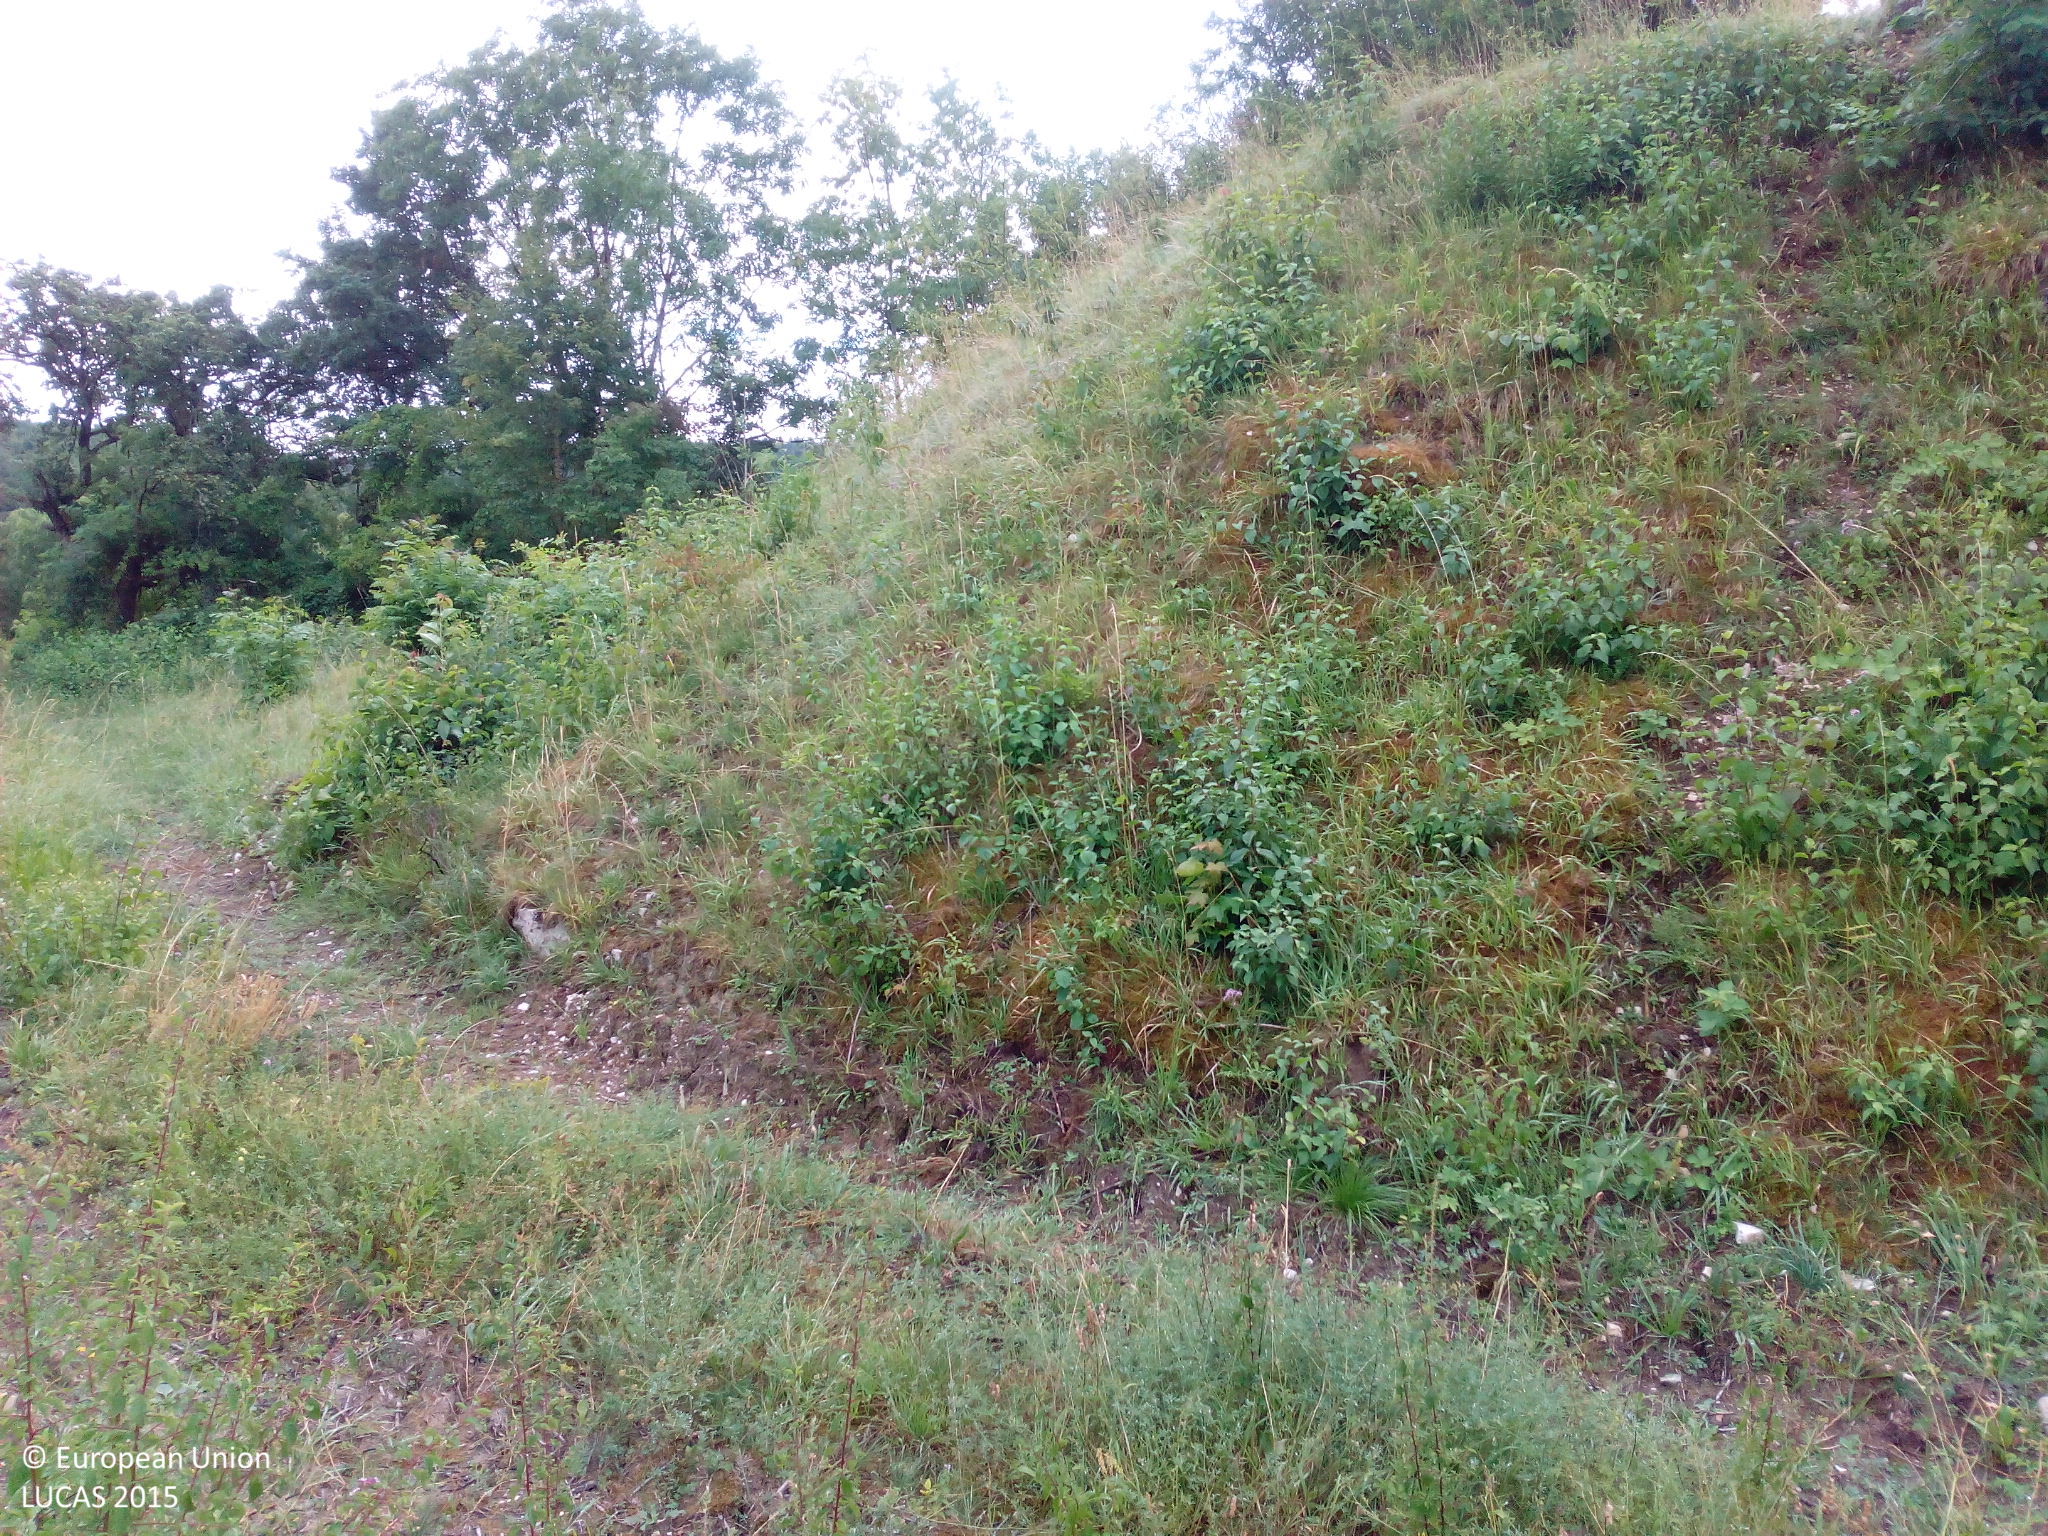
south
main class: Shrubland
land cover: Shrubland with sparse tree cover
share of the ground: > 75 %
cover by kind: herbaceous plants 60 %, shrubs 30 %, broadleaved forest trees 5 %, unconsolidated bare surface 5 %
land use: Semi-natural and natural areas not in use
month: July
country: DE
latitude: 48.8710
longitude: 10.2589
